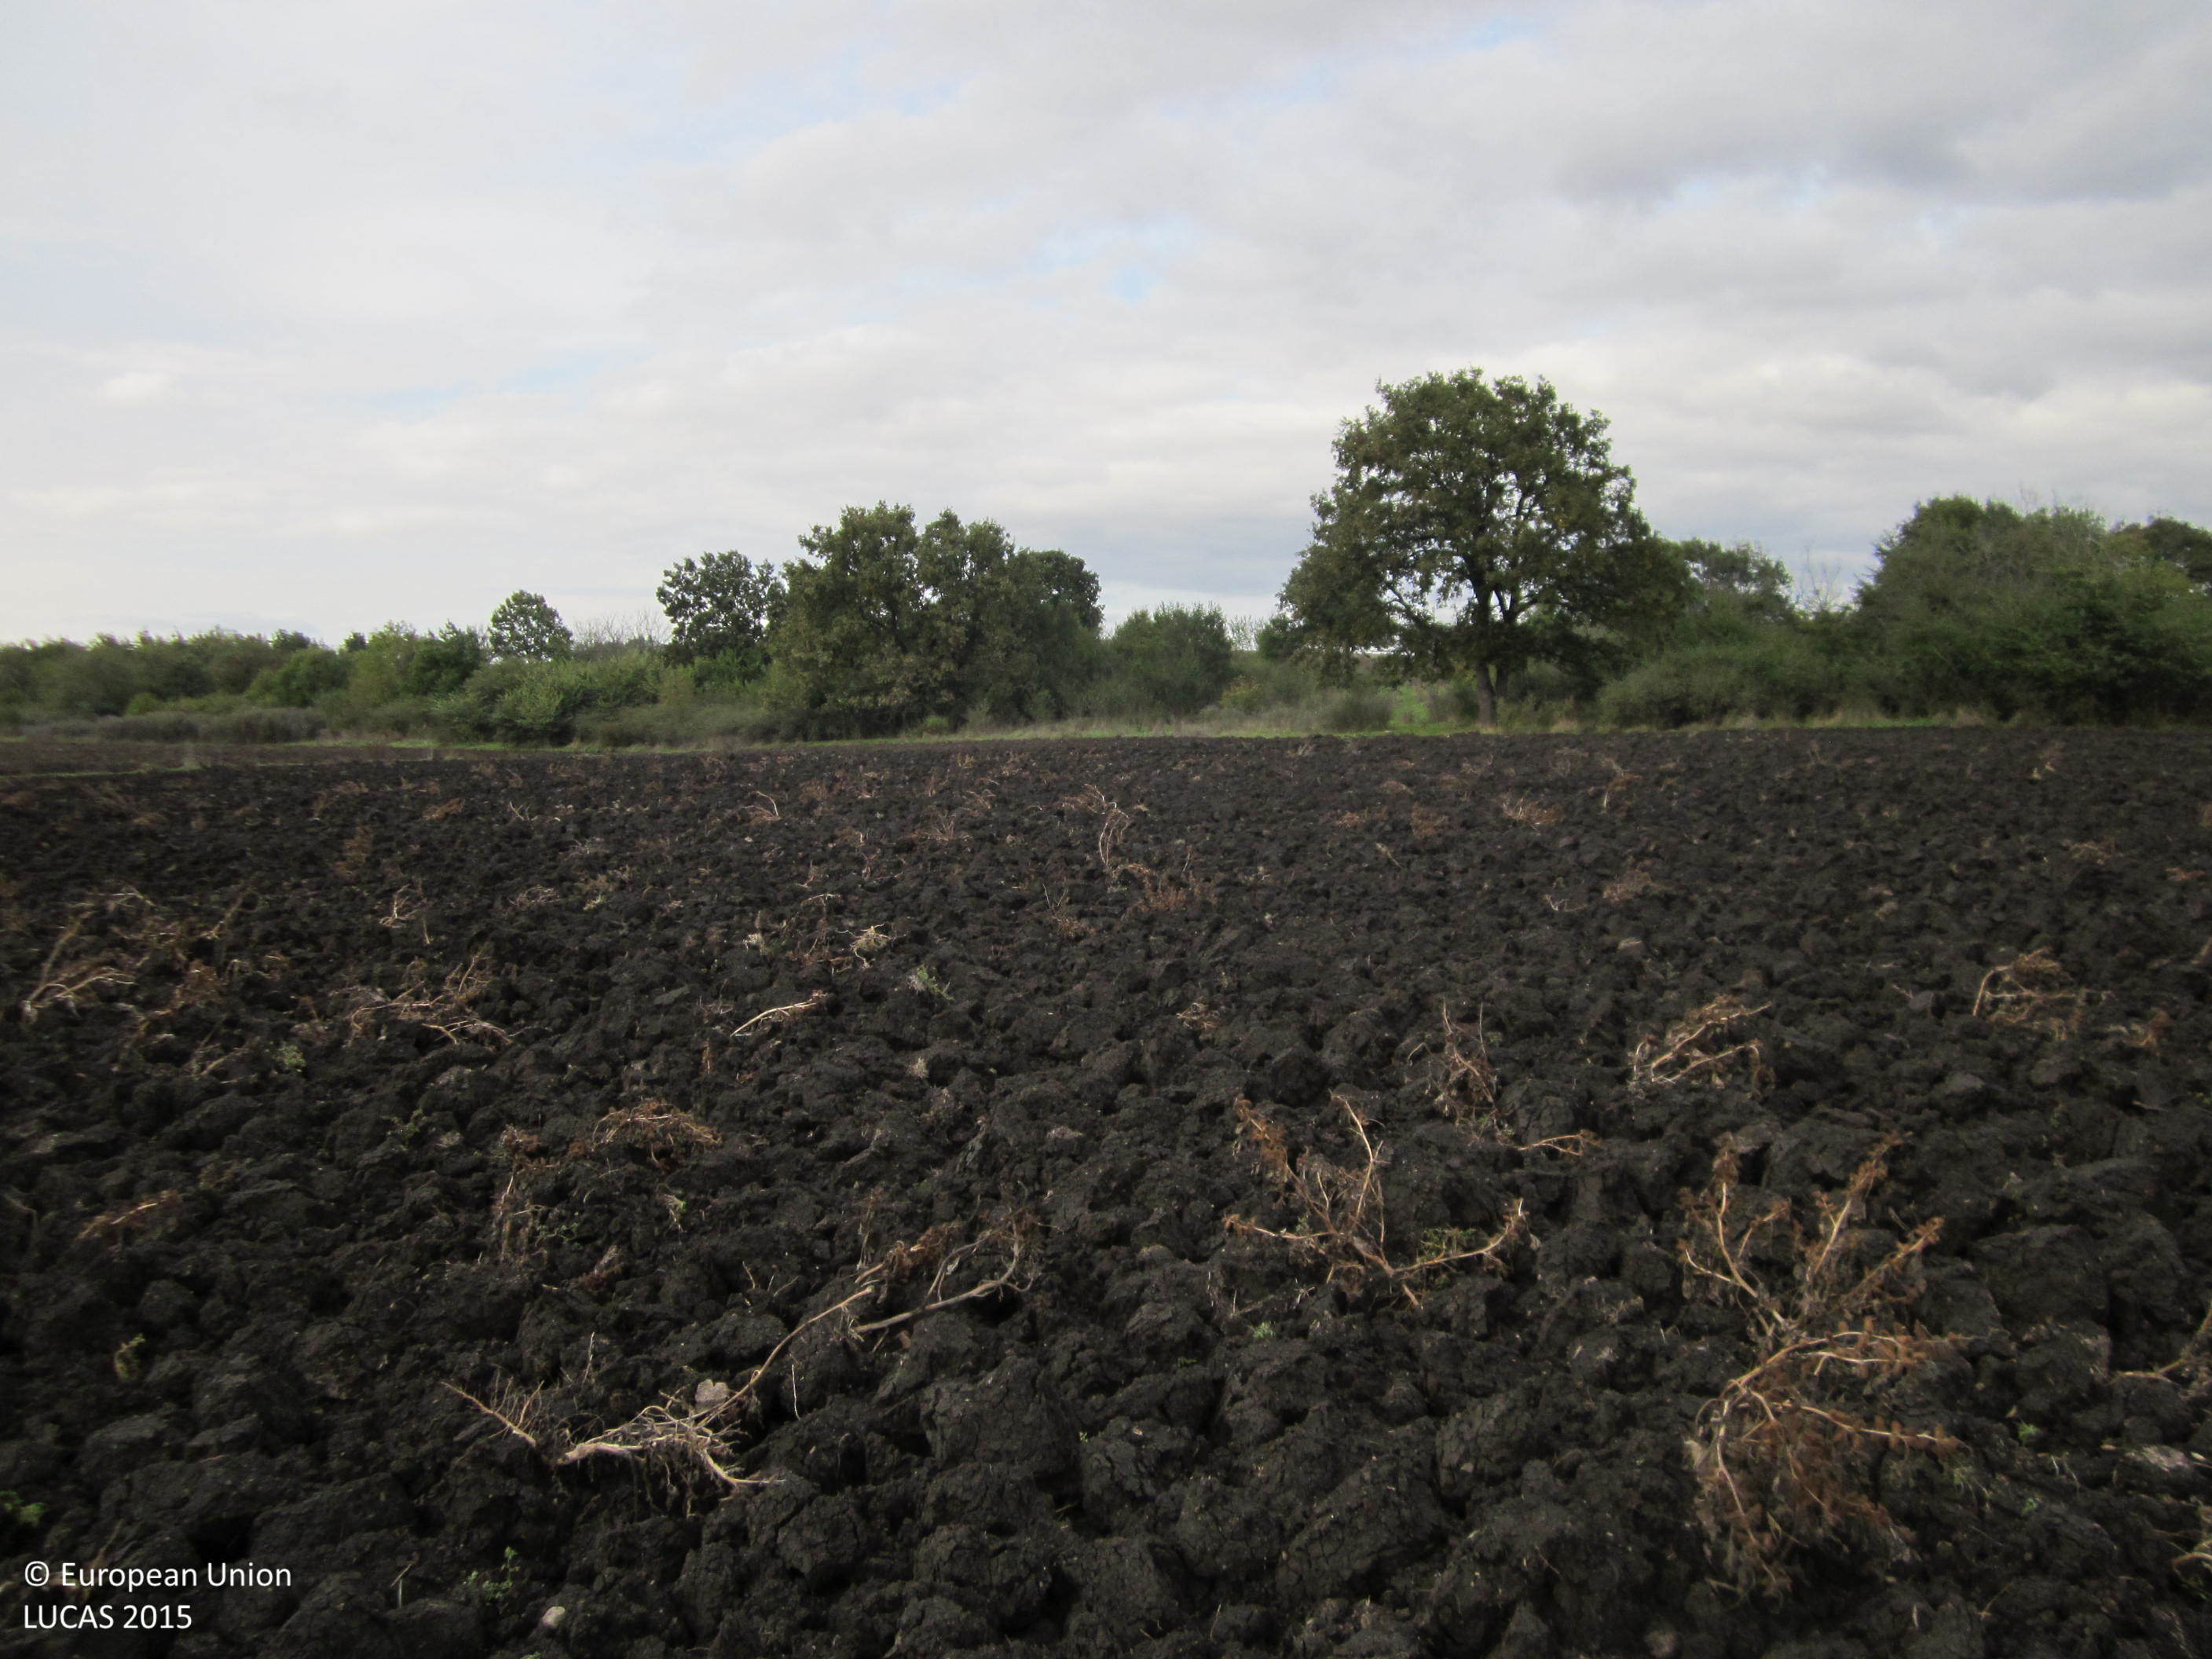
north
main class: Cropland
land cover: Common wheat
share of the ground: < 10 %
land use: Agriculture (excluding fallow land and kitchen gardens)
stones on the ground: < 10 %
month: October
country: BG
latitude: 42.3752
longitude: 27.0456
